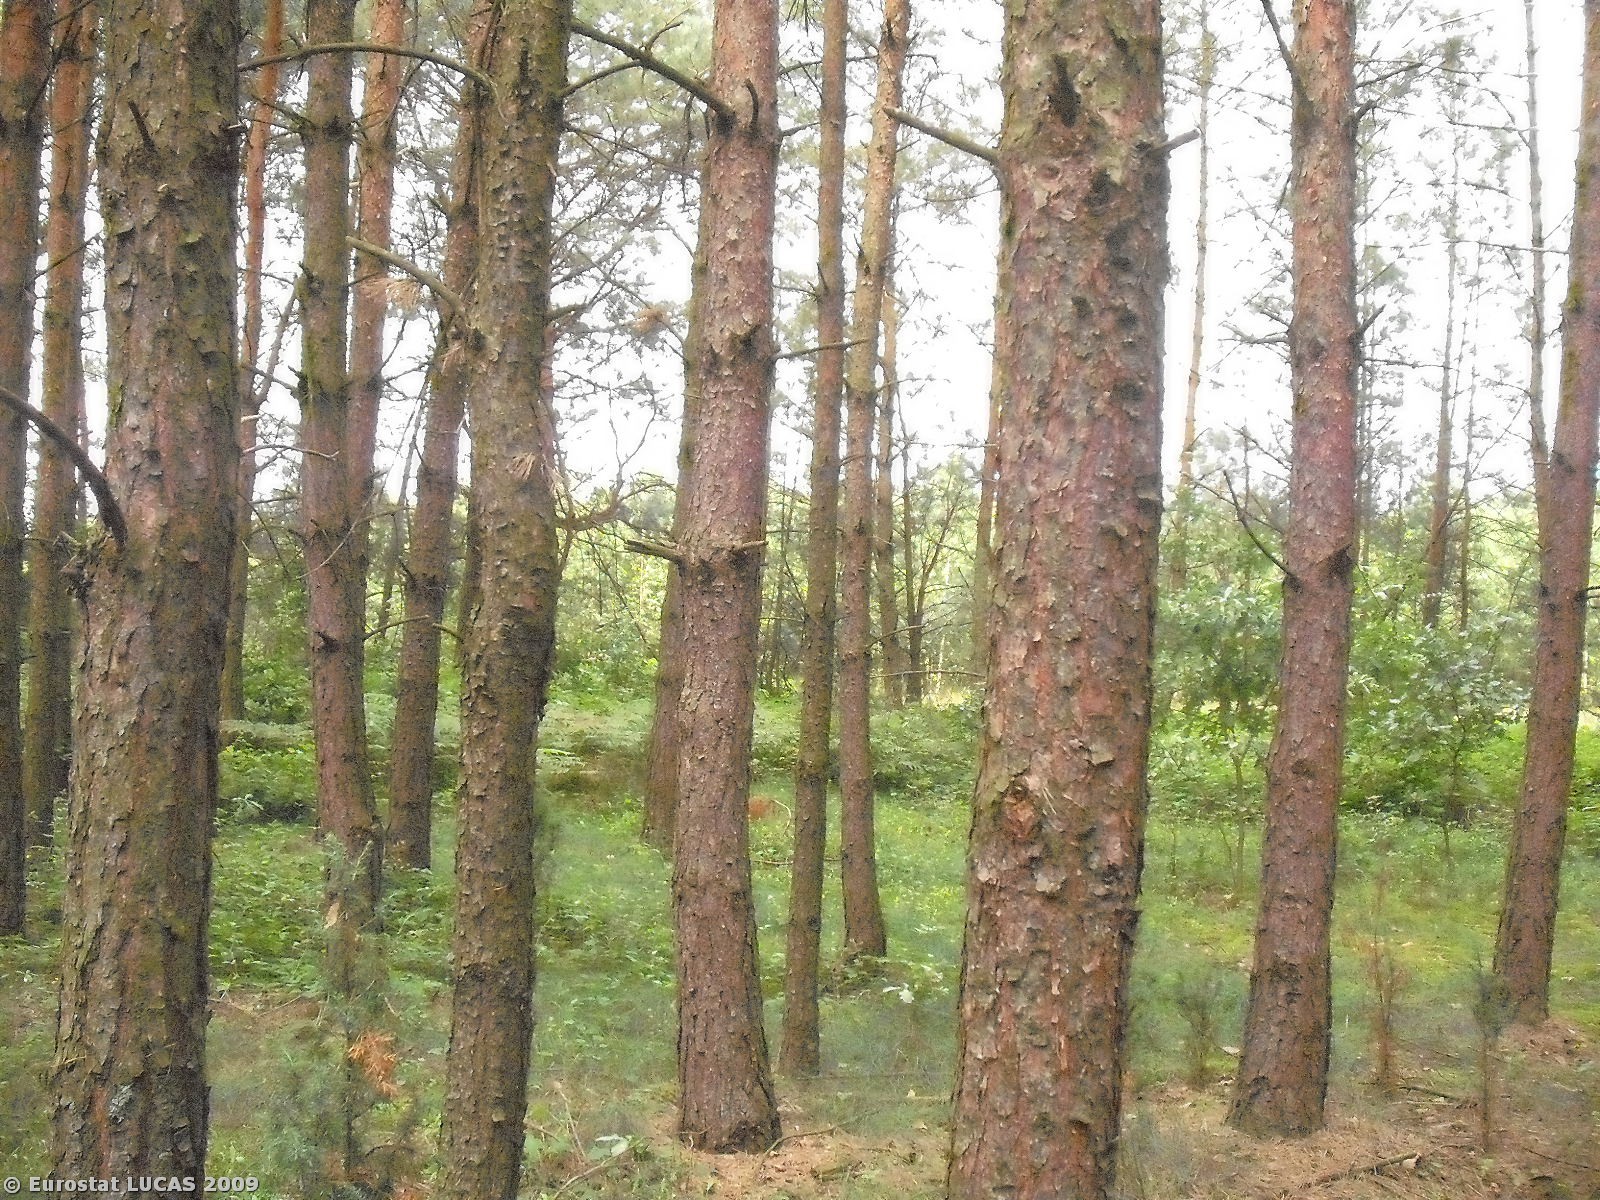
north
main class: Woodland
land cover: Coniferous woodland
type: hemiboreal forest and nemoral coniferous forest and mixed broadleaved-coniferous forest
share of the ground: > 75 %
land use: Forestry
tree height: > 5 m
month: July
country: PL
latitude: 51.2646
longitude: 21.3859
